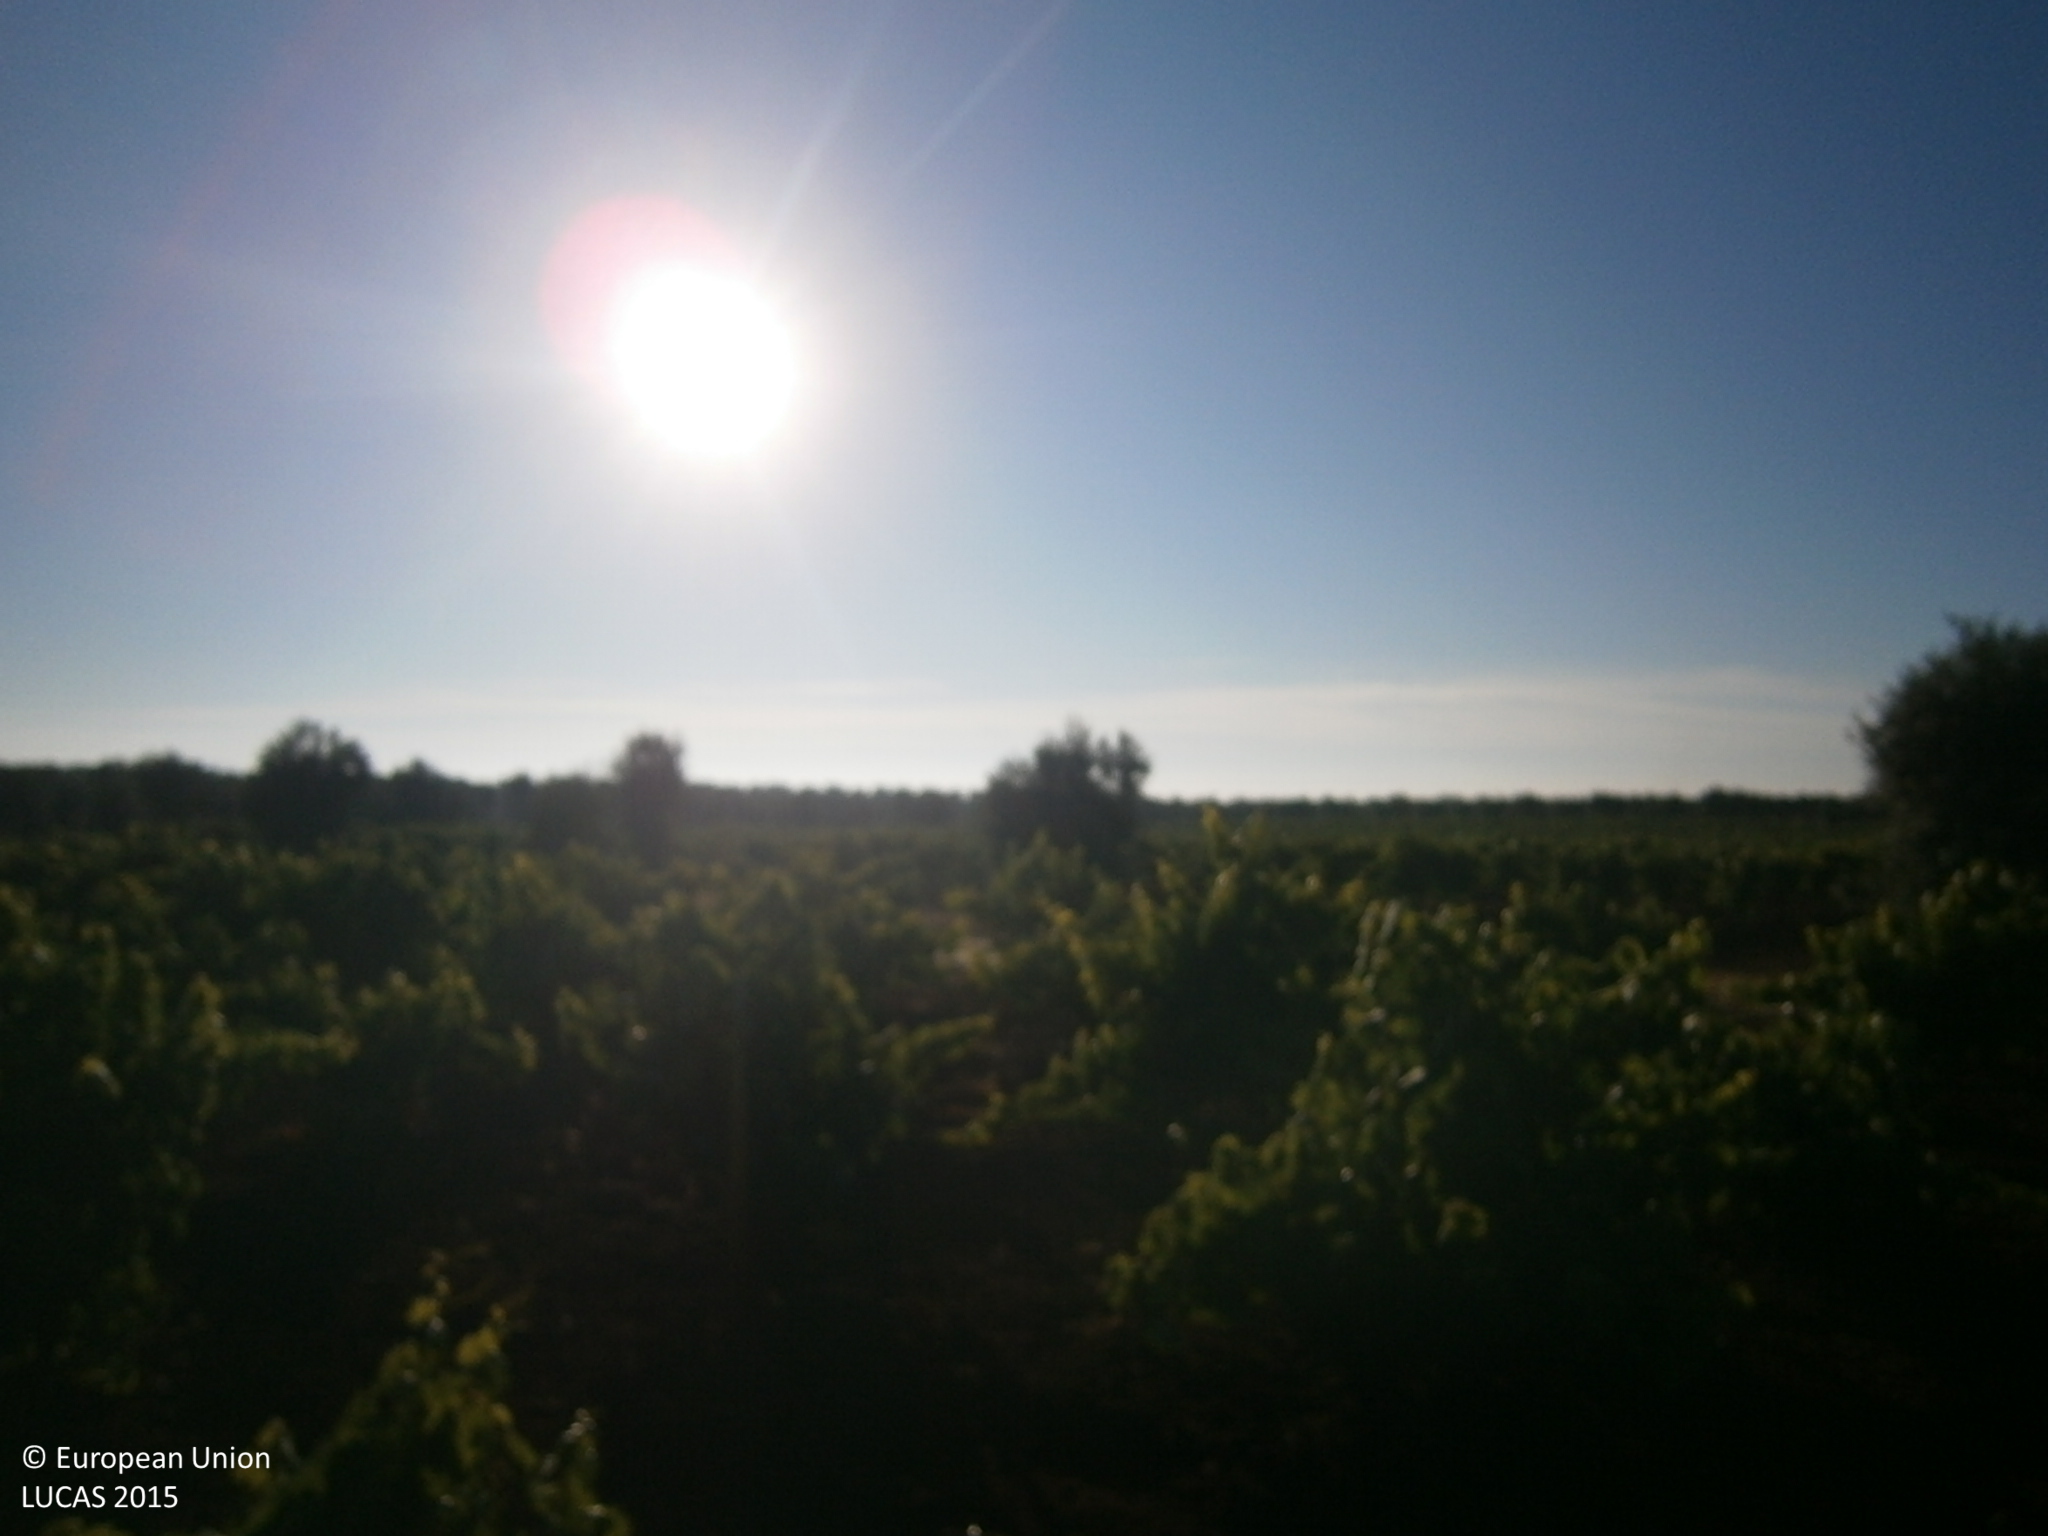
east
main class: Cropland
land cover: Vineyards
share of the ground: 25 - 50 %
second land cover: Other bare soil
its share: > 75 %
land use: Agriculture (excluding fallow land and kitchen gardens)
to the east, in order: Vineyards; Other bare soil; Tracks; Lines of trees; Vineyards; Lines of trees; Tracks; Olive groves; Vineyards
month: June
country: ES
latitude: 38.7566
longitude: -6.4550
